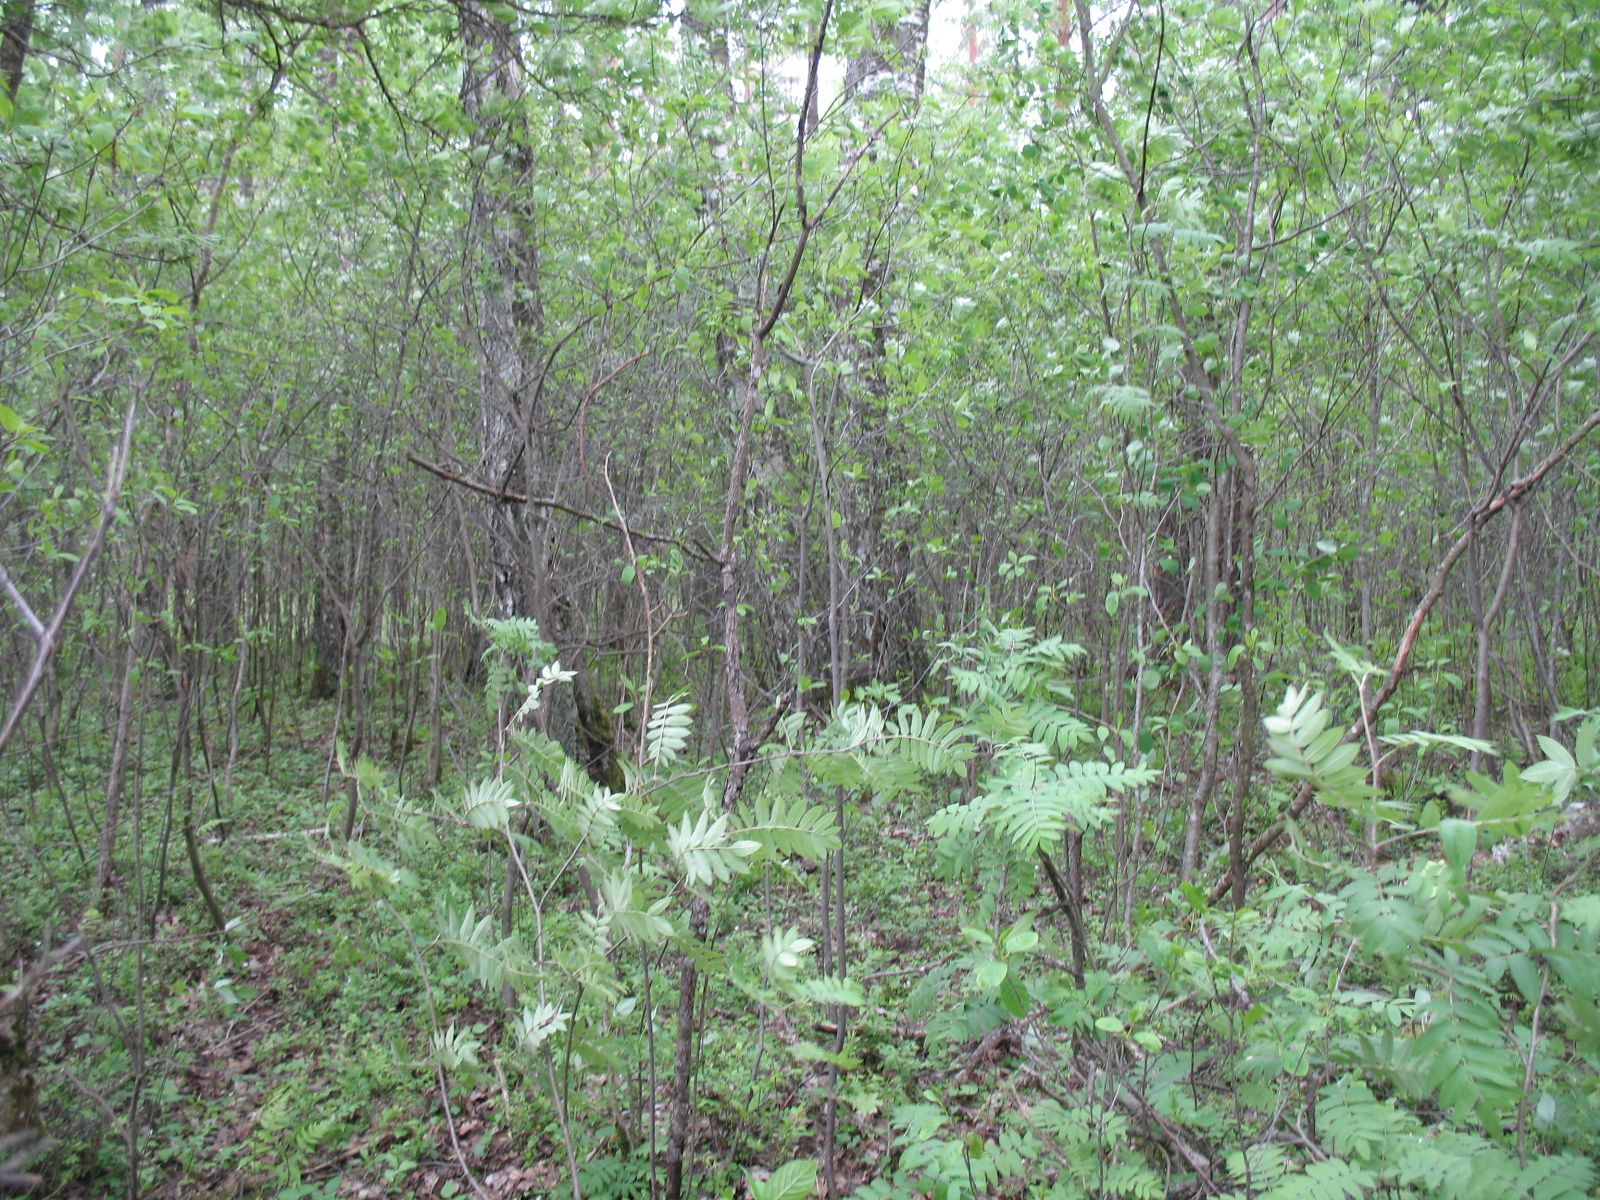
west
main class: Woodland
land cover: Broadleaved woodland
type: non-riverine alder, birch or aspen forest
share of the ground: > 75 %
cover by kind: broadleaved forest trees 95 %, shrubs 5 %
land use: Forestry
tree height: > 5 m
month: May
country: LV
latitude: 56.7803
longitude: 23.5442
